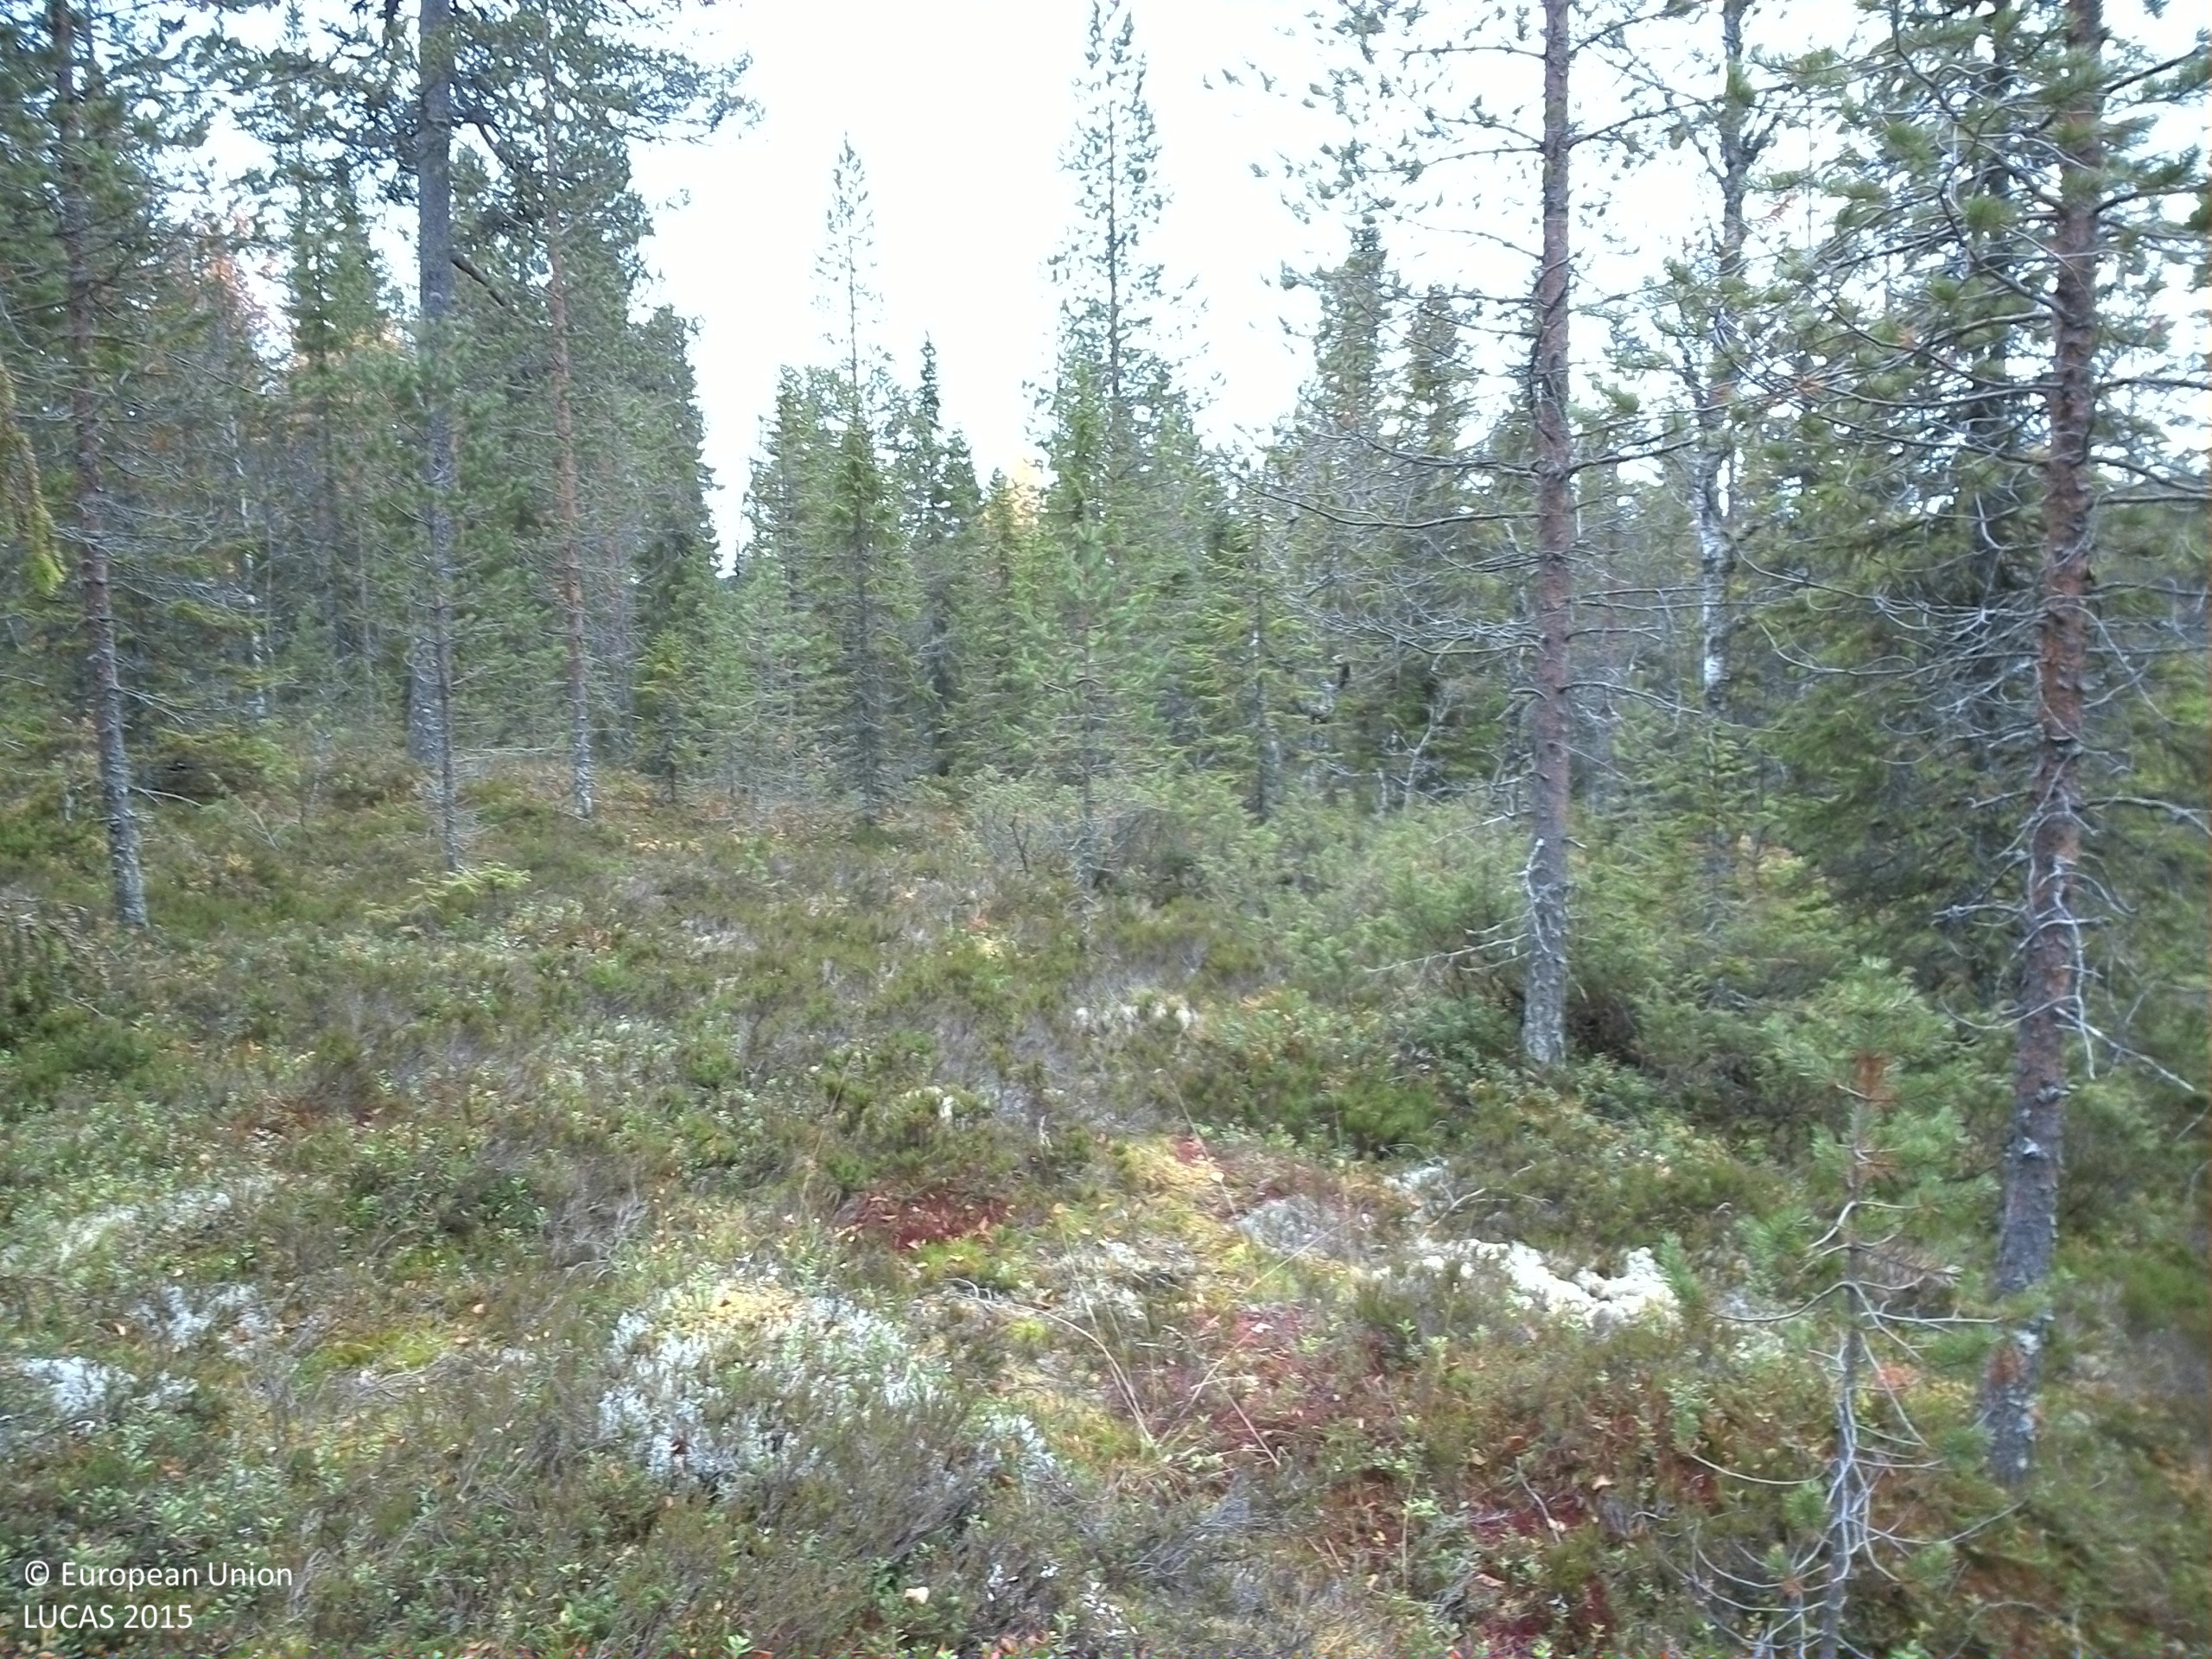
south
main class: Woodland
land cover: Spruce dominated mixed woodland
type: boreal forest
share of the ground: 25 - 50 %
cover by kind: shrubs 35 %, coniferous forest trees 30 %, lichens and mosses 20 %, broadleaved forest trees 15 %
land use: Forestry
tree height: > 5 m
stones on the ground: < 10 %
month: October
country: SE
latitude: 61.4291
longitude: 14.3904
